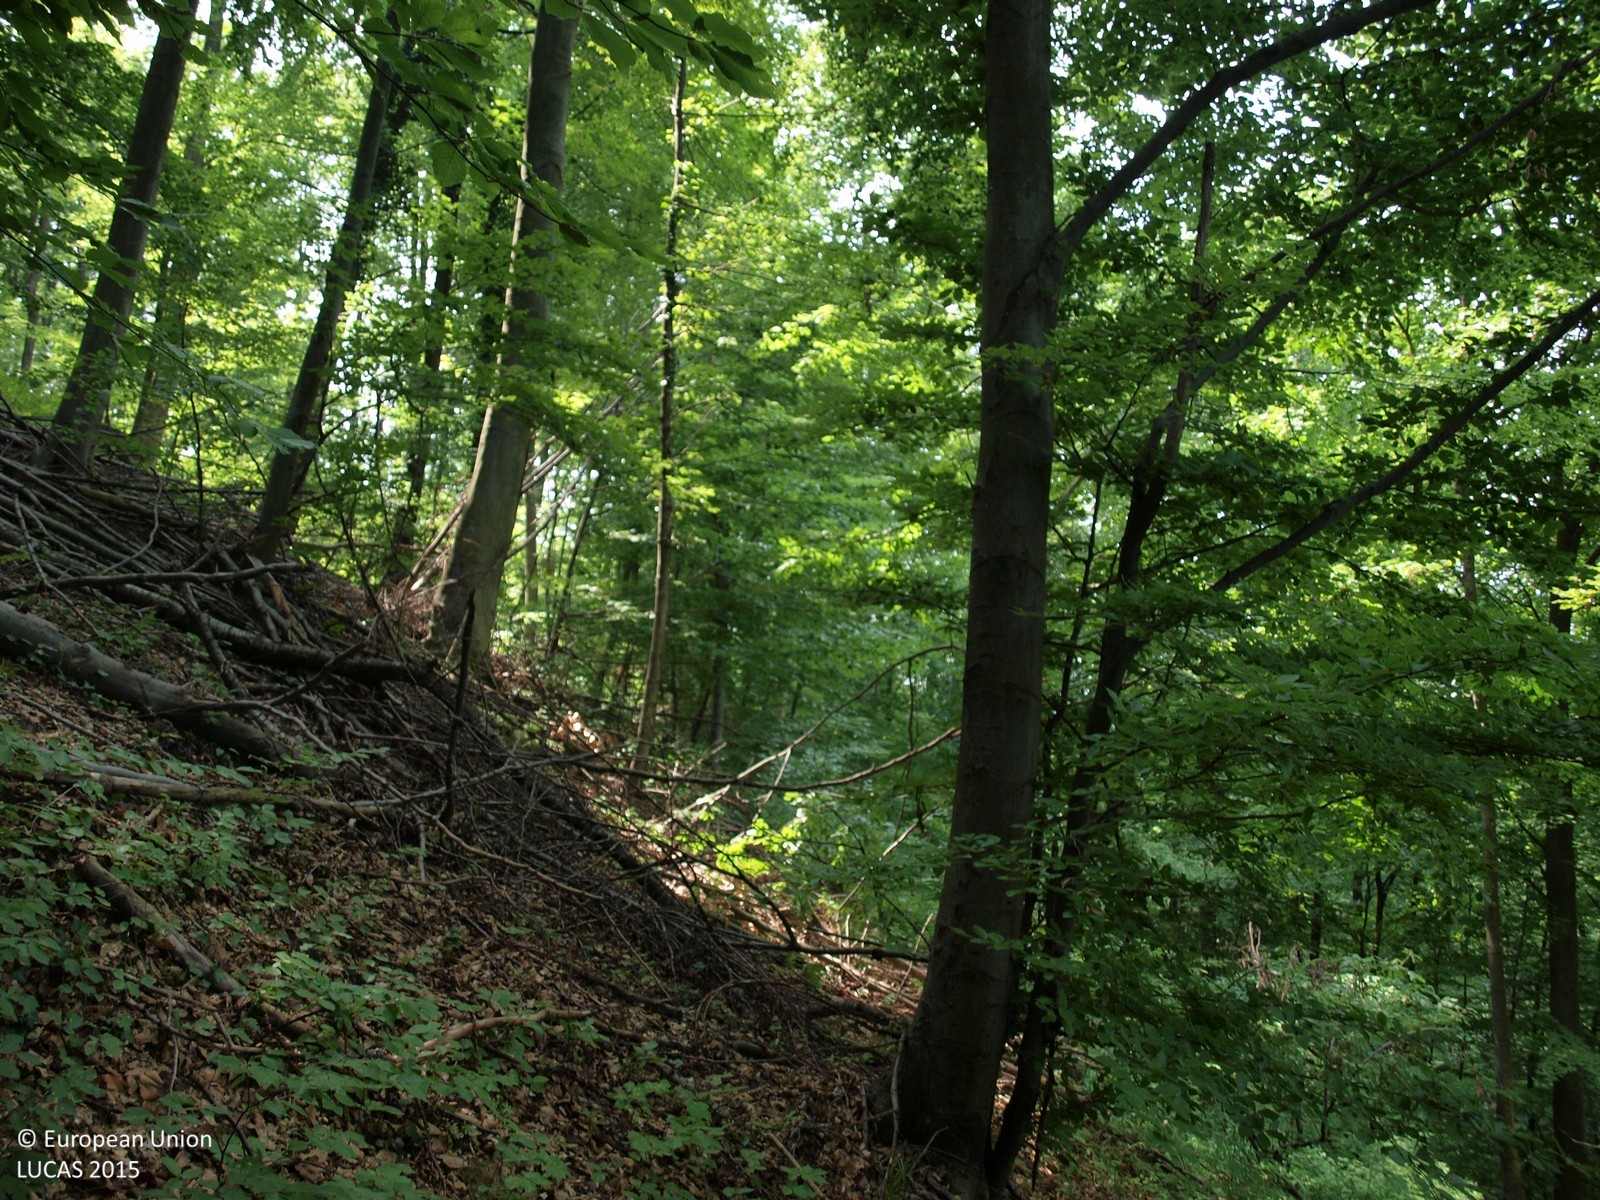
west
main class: Woodland
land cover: Broadleaved woodland
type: beech forest
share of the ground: > 75 %
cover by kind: broadleaved forest trees 100 %
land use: Forestry
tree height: > 5 m
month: July
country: HR
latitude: 45.9932
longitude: 16.1573
